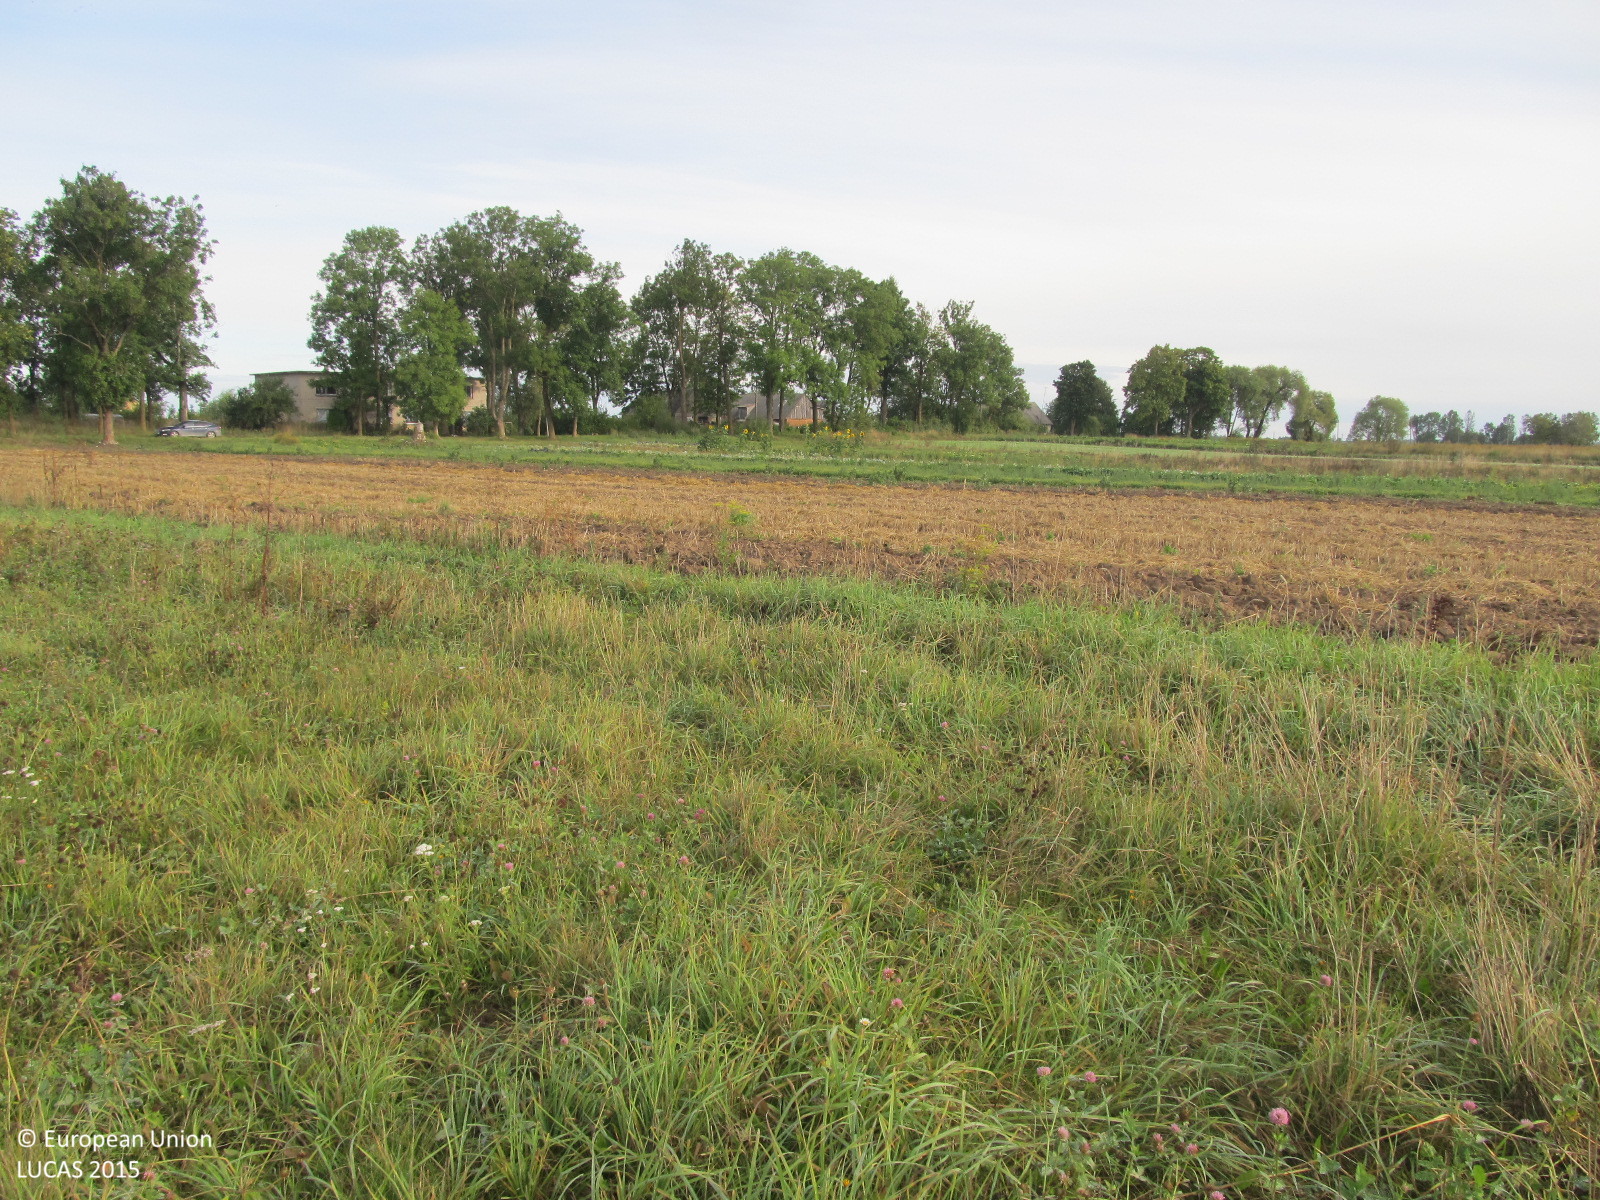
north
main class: Grassland
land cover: Grassland without tree/shrub cover
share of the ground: > 75 %
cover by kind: herbaceous plants 100 %
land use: Agriculture (excluding fallow land and kitchen gardens)
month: September
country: LT
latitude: 56.3115
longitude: 23.3116
